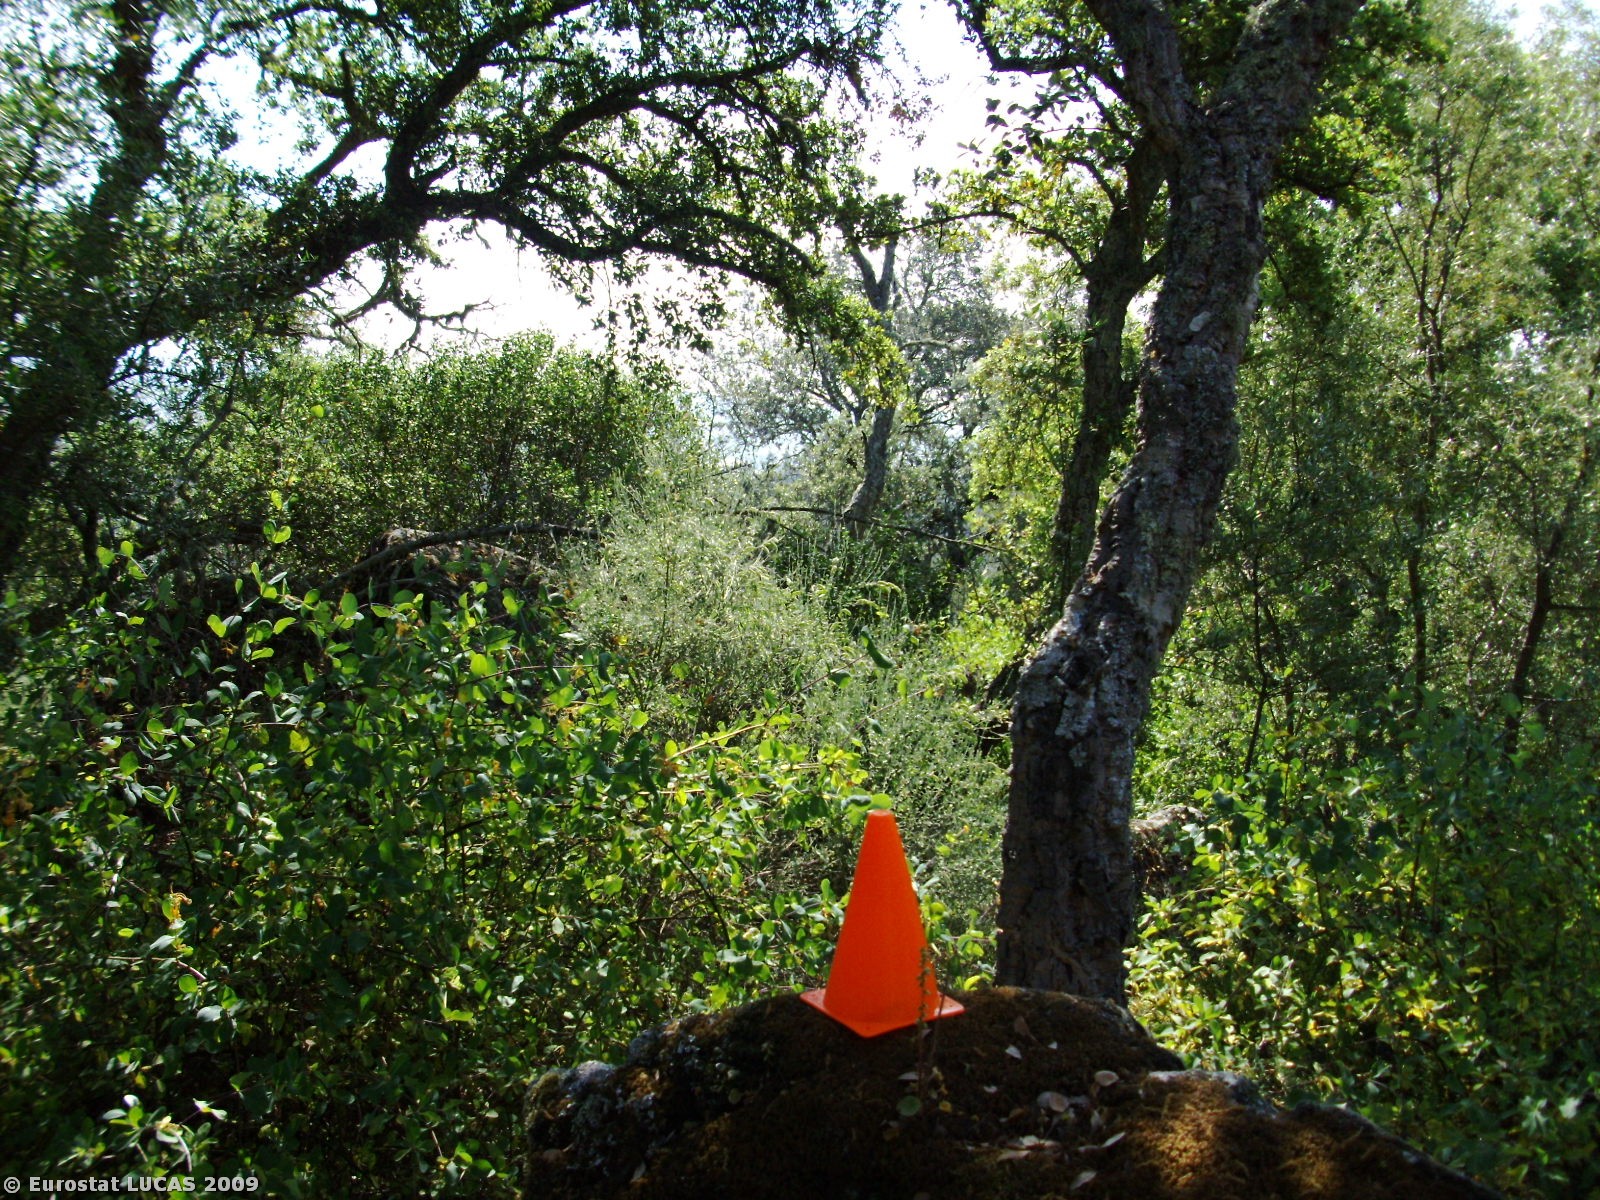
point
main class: Woodland
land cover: Broadleaved woodland
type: broadleaved evergreen forest
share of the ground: 50 - 75 %
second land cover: Shrubland with sparse tree cover
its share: 25 - 50 %
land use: Forestry
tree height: > 5 m
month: May
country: PT
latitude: 39.2778
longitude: -7.4650
